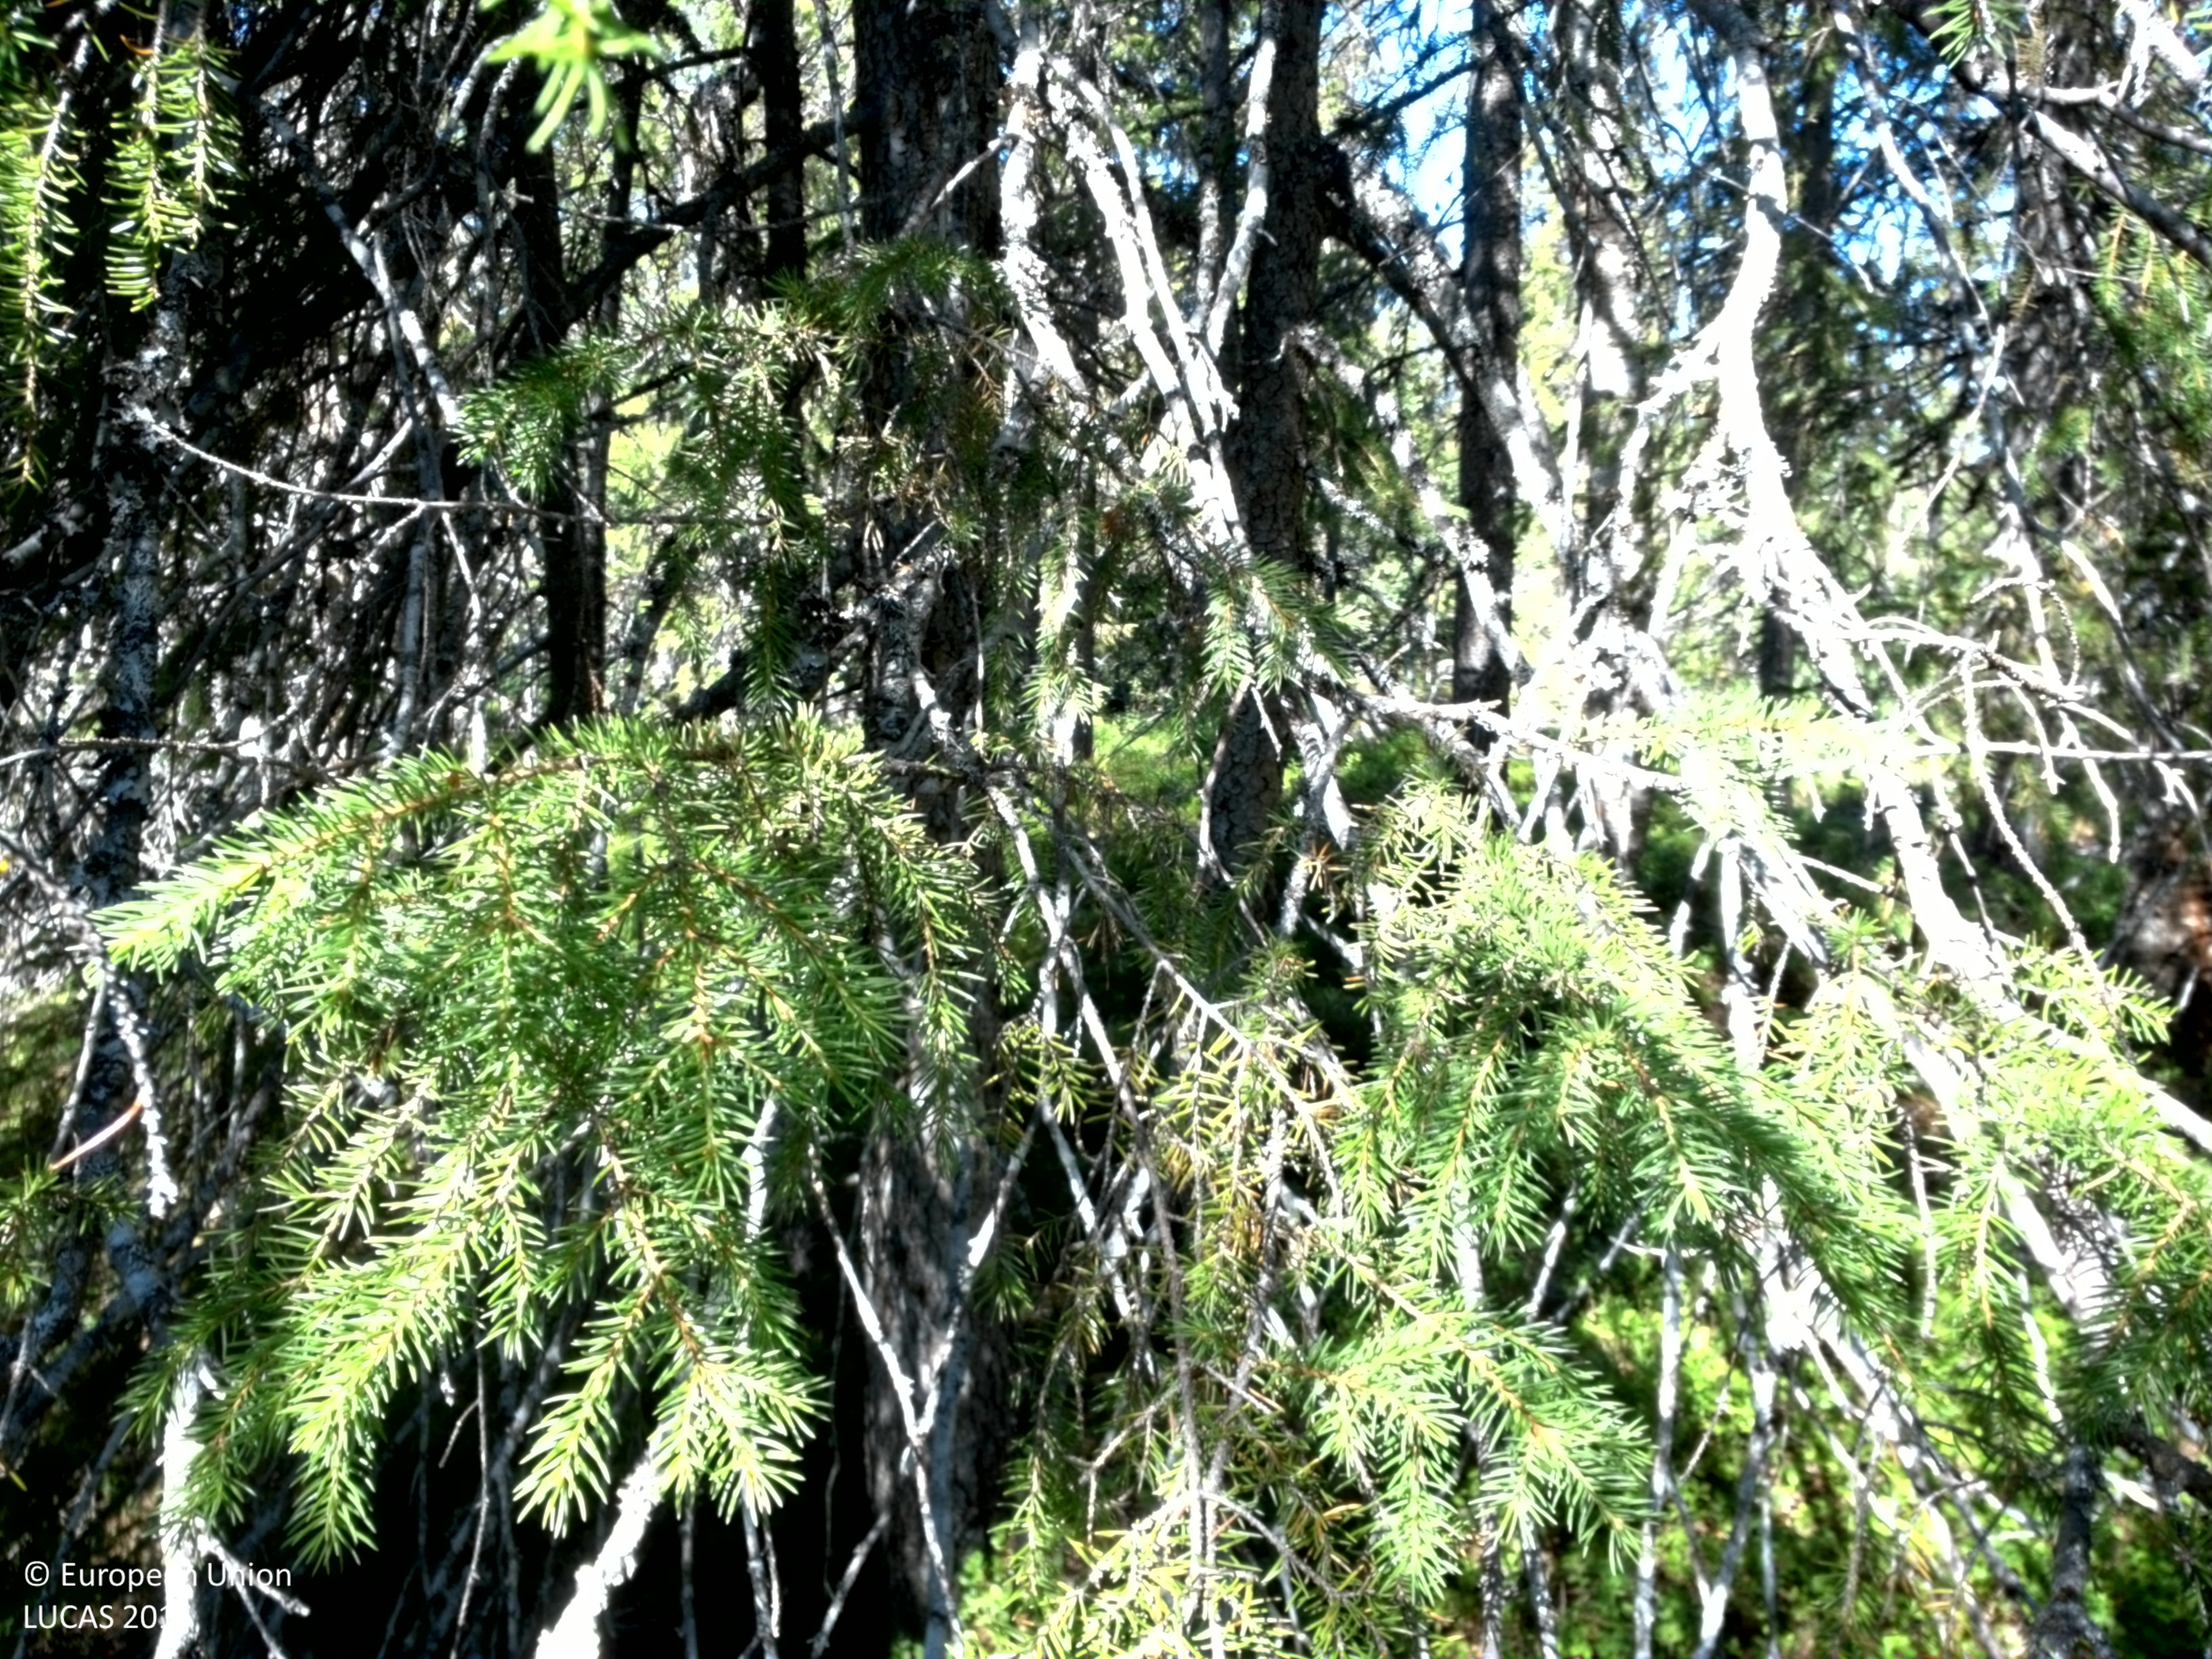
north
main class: Woodland
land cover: Spruce dominated coniferous woodland
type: boreal forest
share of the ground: 25 - 50 %
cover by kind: shrubs 50 %, coniferous forest trees 35 %, lichens and mosses 15 %
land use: Forestry
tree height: > 5 m
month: August
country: SE
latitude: 64.8728
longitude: 15.7715
